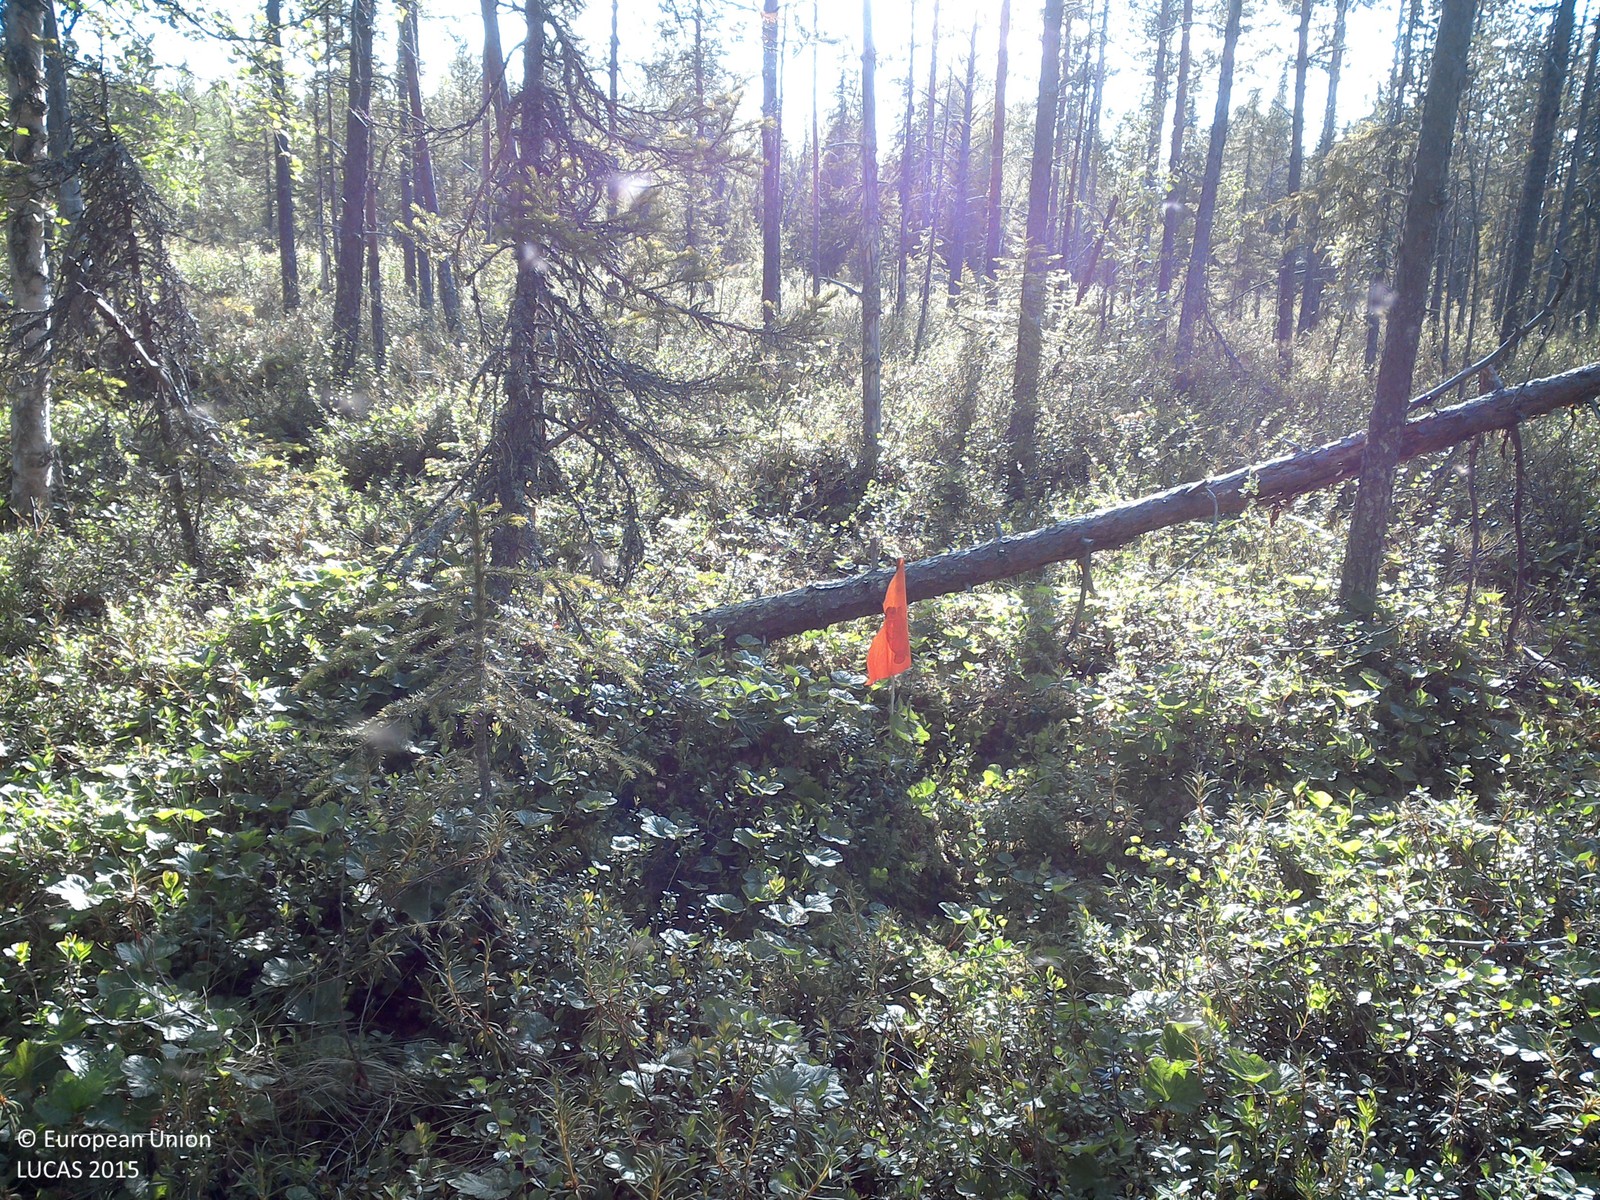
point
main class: Woodland
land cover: Pine dominated mixed woodland
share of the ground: 10 - 25 %
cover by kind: shrubs 45 %, herbaceous plants 20 %, coniferous forest trees 15 %, lichens and mosses 15 %, broadleaved forest trees 5 %
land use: Forestry
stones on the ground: < 10 %
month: July
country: SE
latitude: 67.2667
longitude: 22.6938
